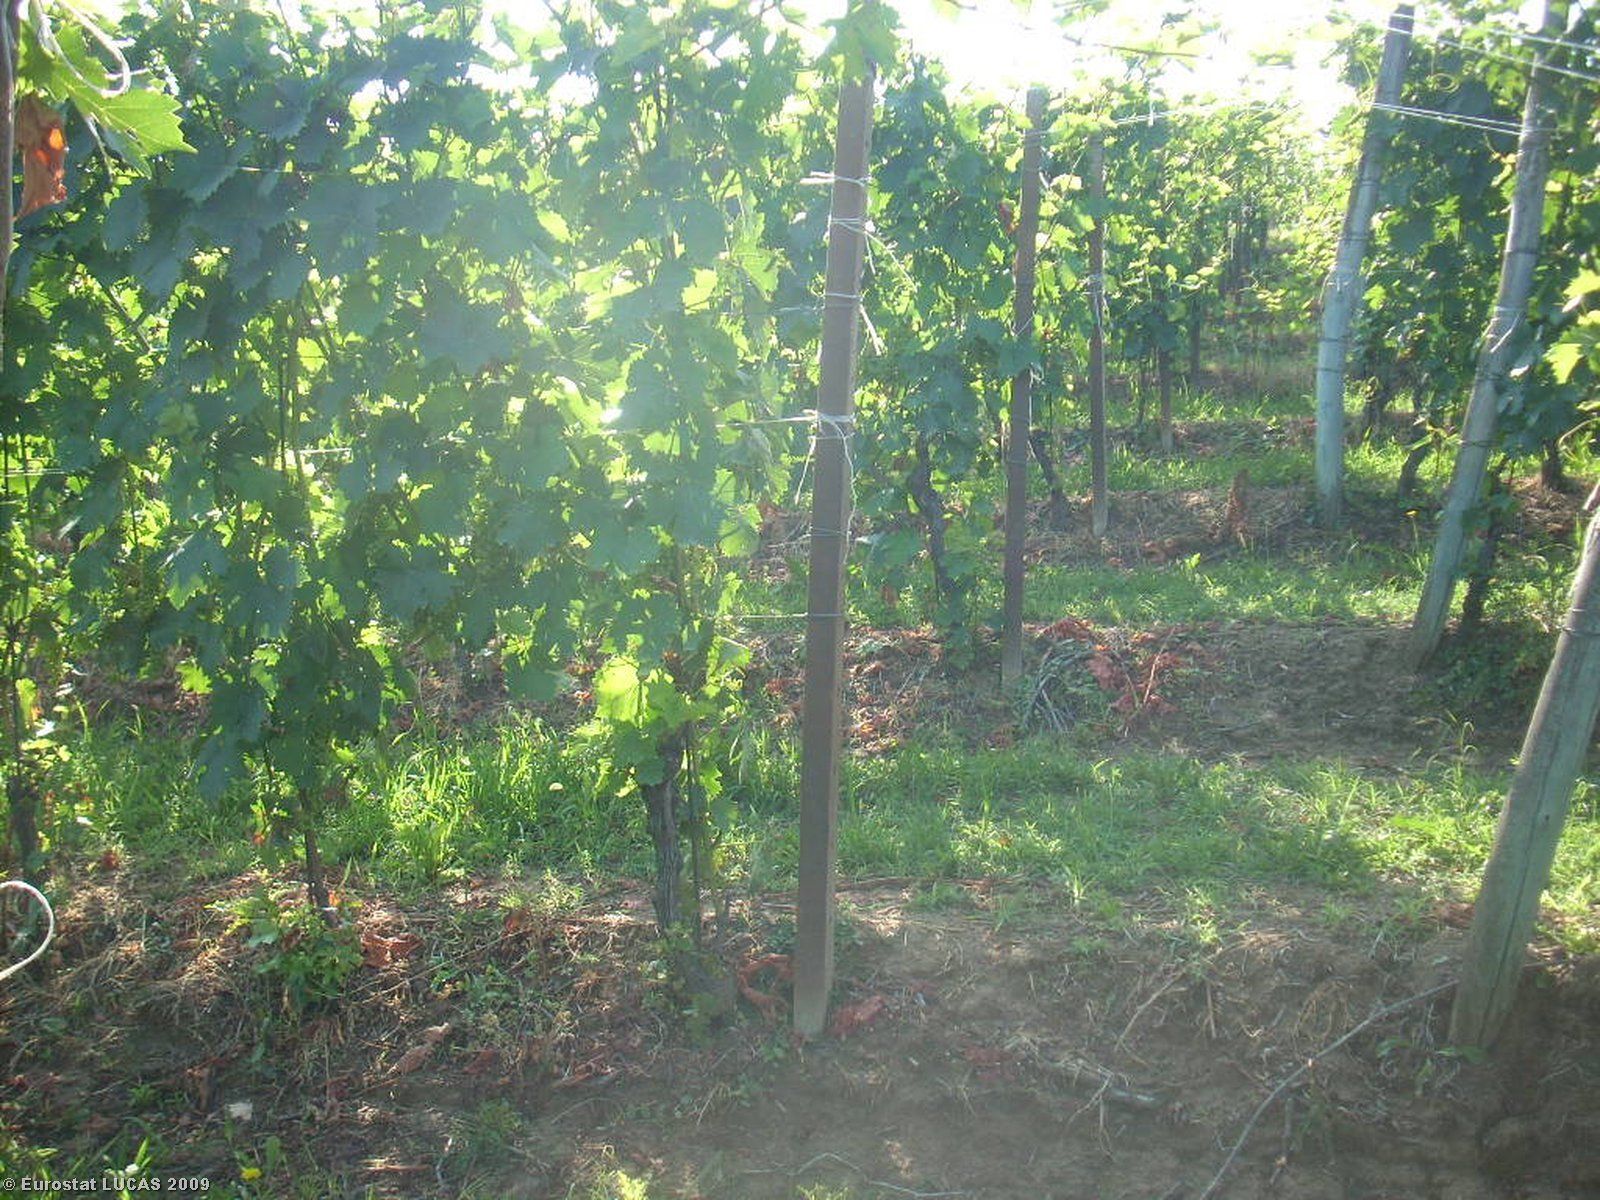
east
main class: Cropland
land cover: Vineyards
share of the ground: 10 - 25 %
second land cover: Grassland with sparse tree/shrub cover
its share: > 75 %
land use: Agriculture (excluding fallow land and kitchen gardens)
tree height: < 5 m
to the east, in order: Vineyards; Grassland with sparse tree/shrub cover; Artificial constructions in urban areas; Paved roads, cycling and walking lanes; Artificial constructions in urban areas; Broadleaved woodland
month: July
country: IT
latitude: 44.7300
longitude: 8.0972
